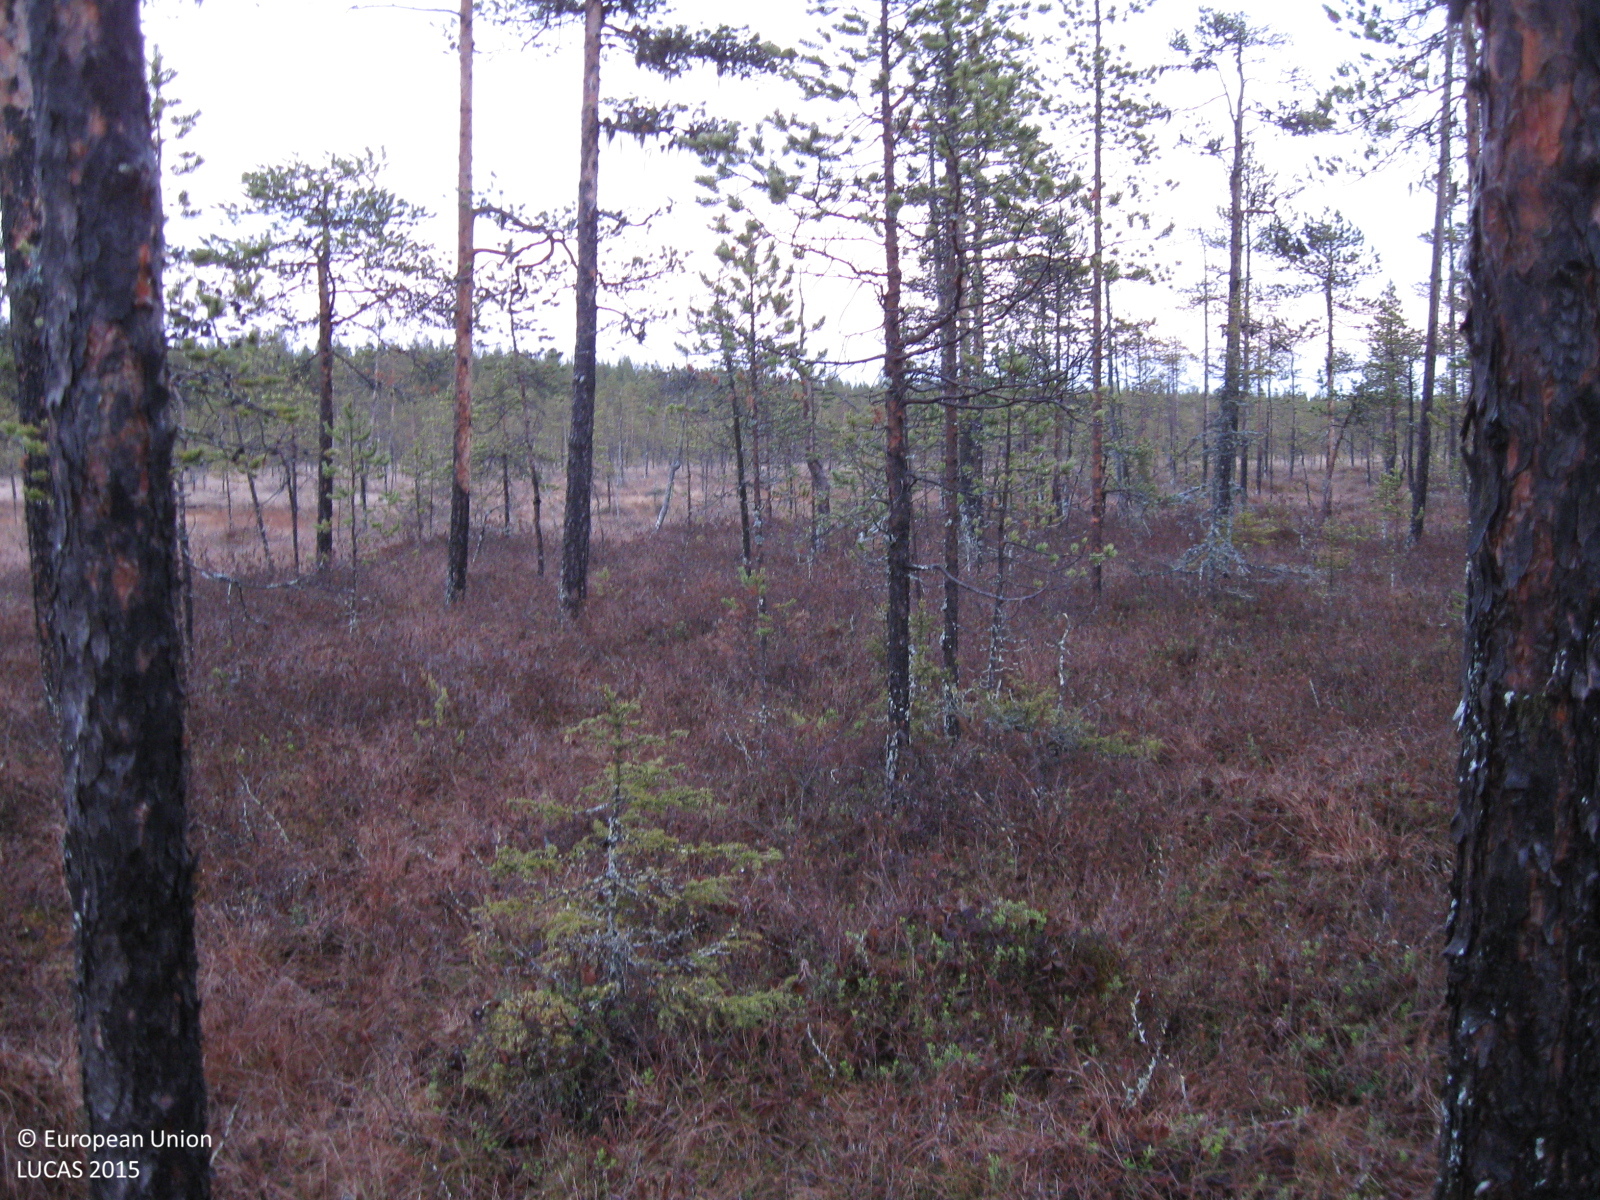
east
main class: Woodland
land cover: Pine dominated coniferous woodland
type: mire and swamp forests
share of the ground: 25 - 50 %
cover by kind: shrubs 40 %, coniferous forest trees 35 %, herbaceous plants 15 %, lichens and mosses 10 %
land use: Semi-natural and natural areas not in use
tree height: < 5 m
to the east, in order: Pine dominated coniferous woodland; Peatbogs; Shrubland with sparse tree cover; Pine dominated coniferous woodland
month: October
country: SE
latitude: 66.4341
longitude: 20.9201
